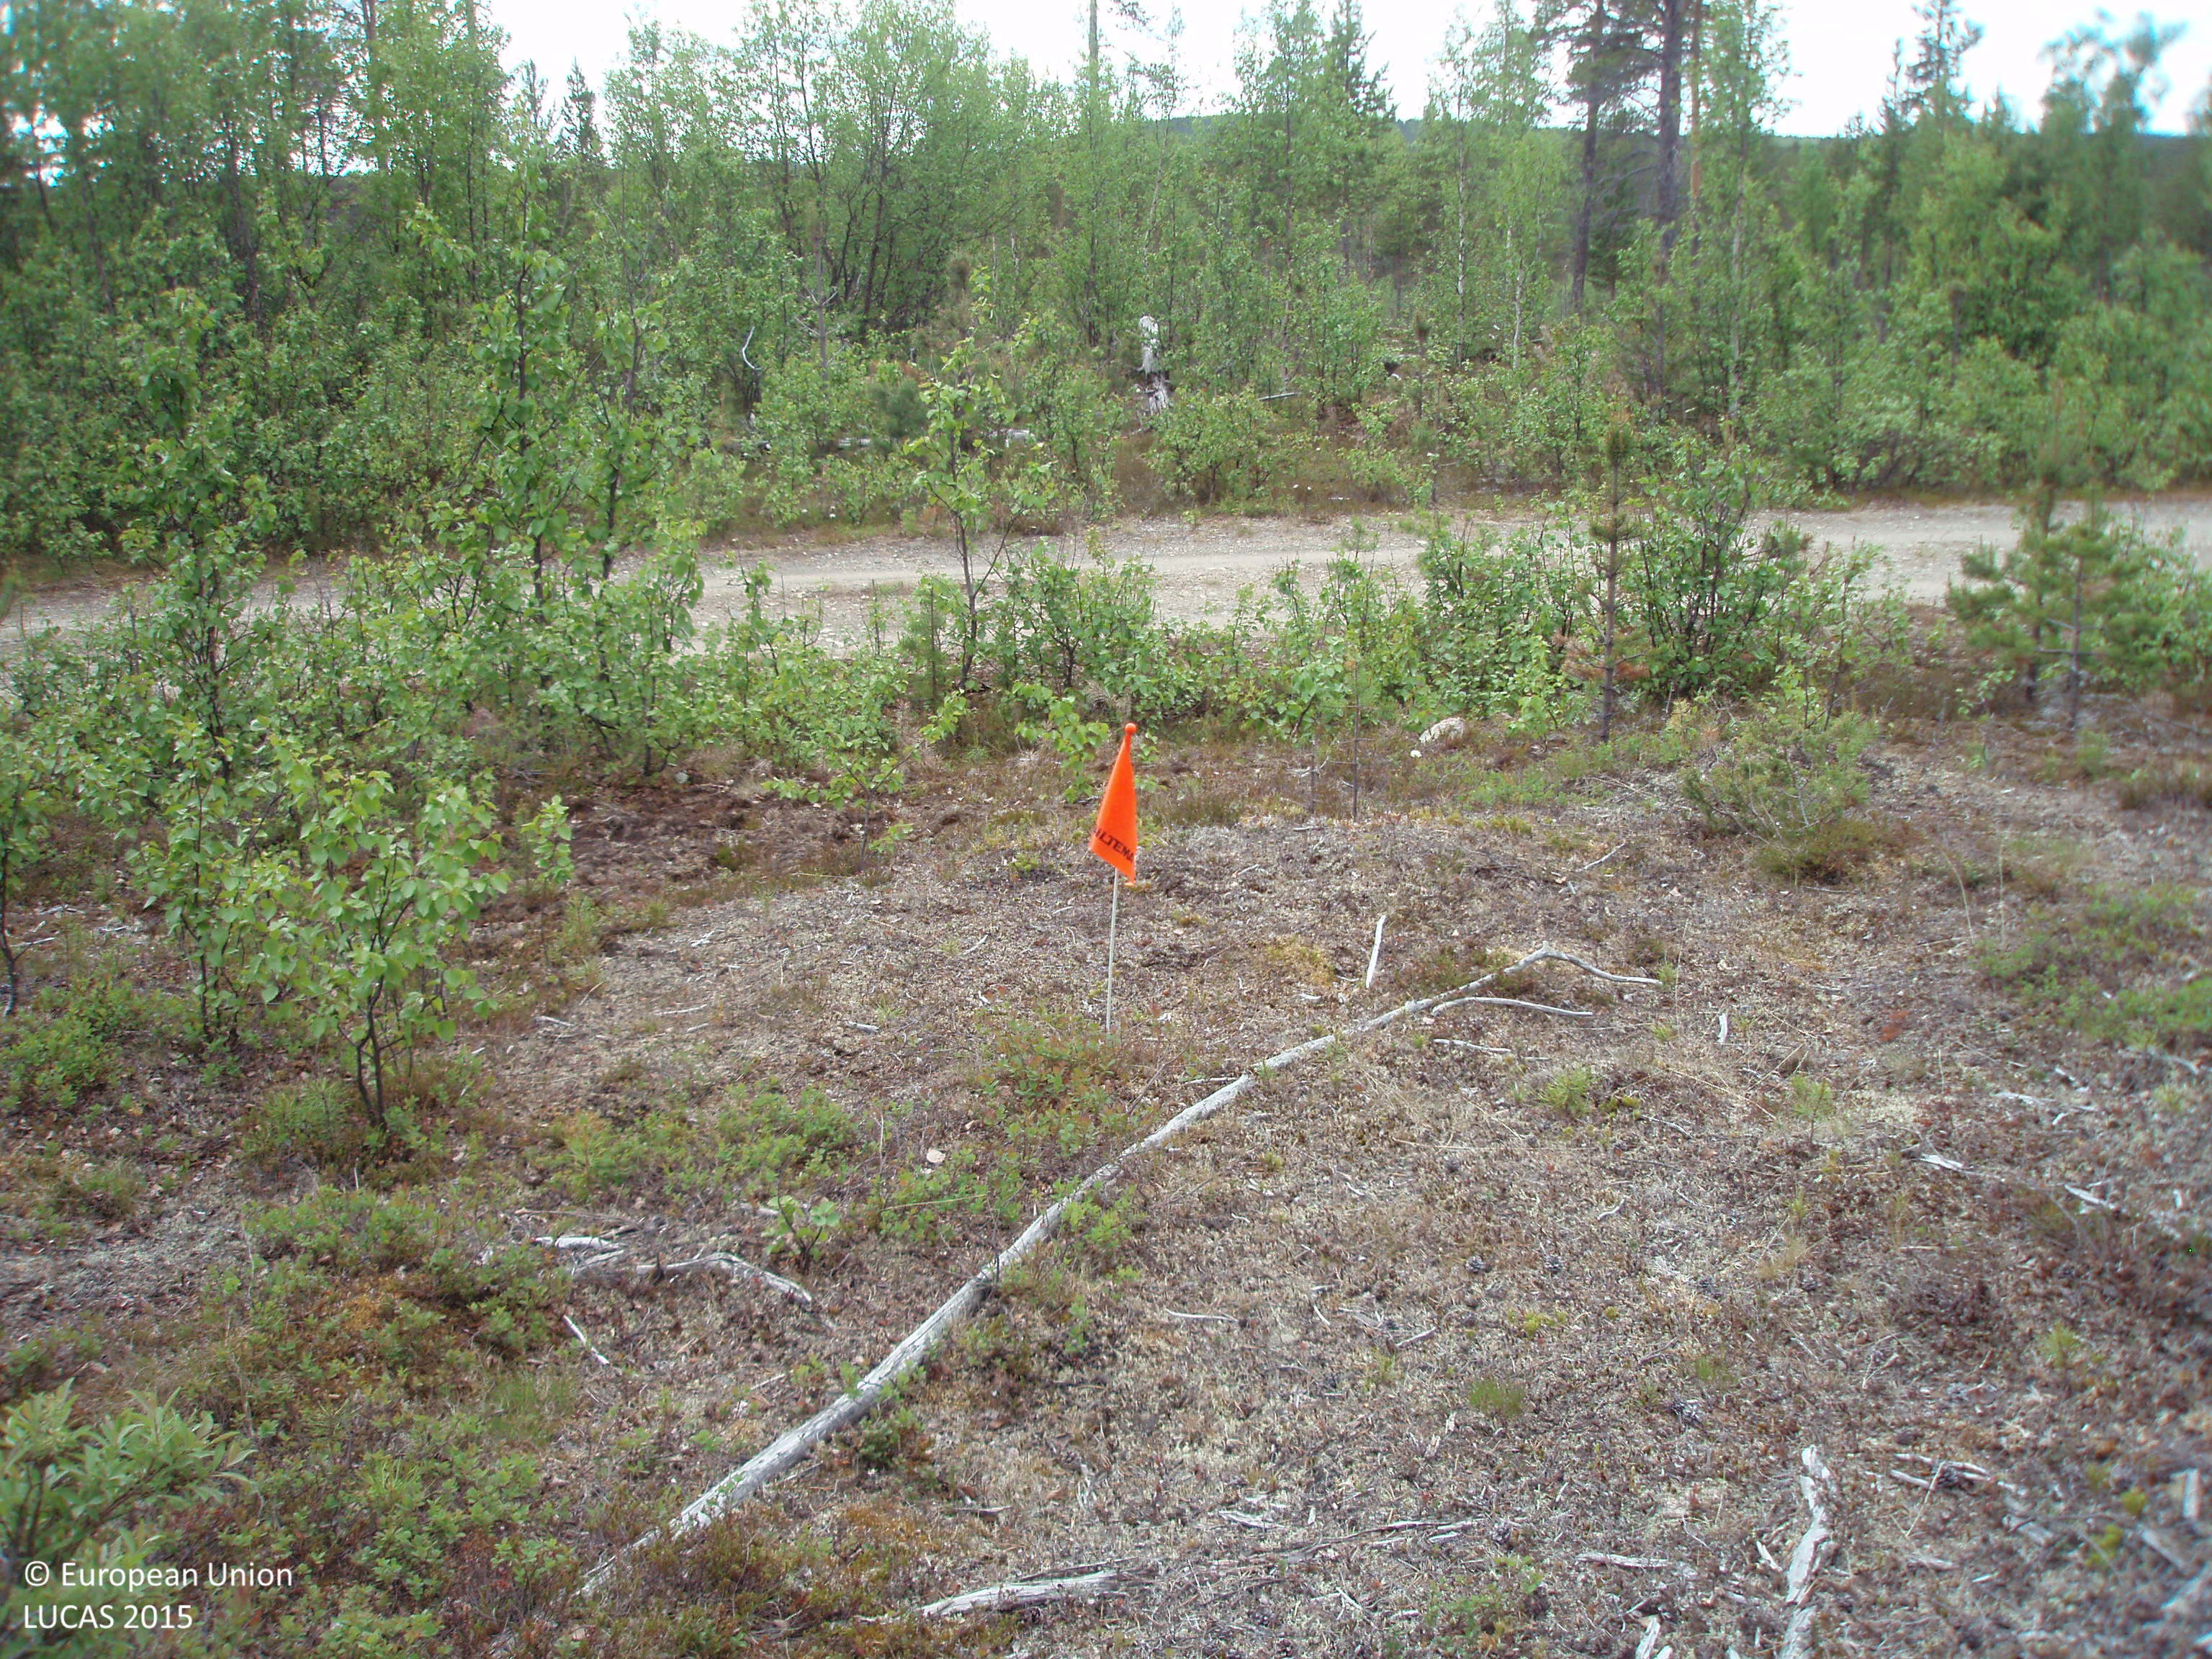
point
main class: Woodland
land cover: Pine dominated mixed woodland
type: boreal forest
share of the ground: 50 - 75 %
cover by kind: coniferous forest trees 30 %, shrubs 30 %, broadleaved forest trees 20 %, unconsolidated bare surface 20 %
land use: Forestry
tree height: > 5 m
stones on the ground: < 10 %
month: July
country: FI
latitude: 68.8732
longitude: 25.7690
